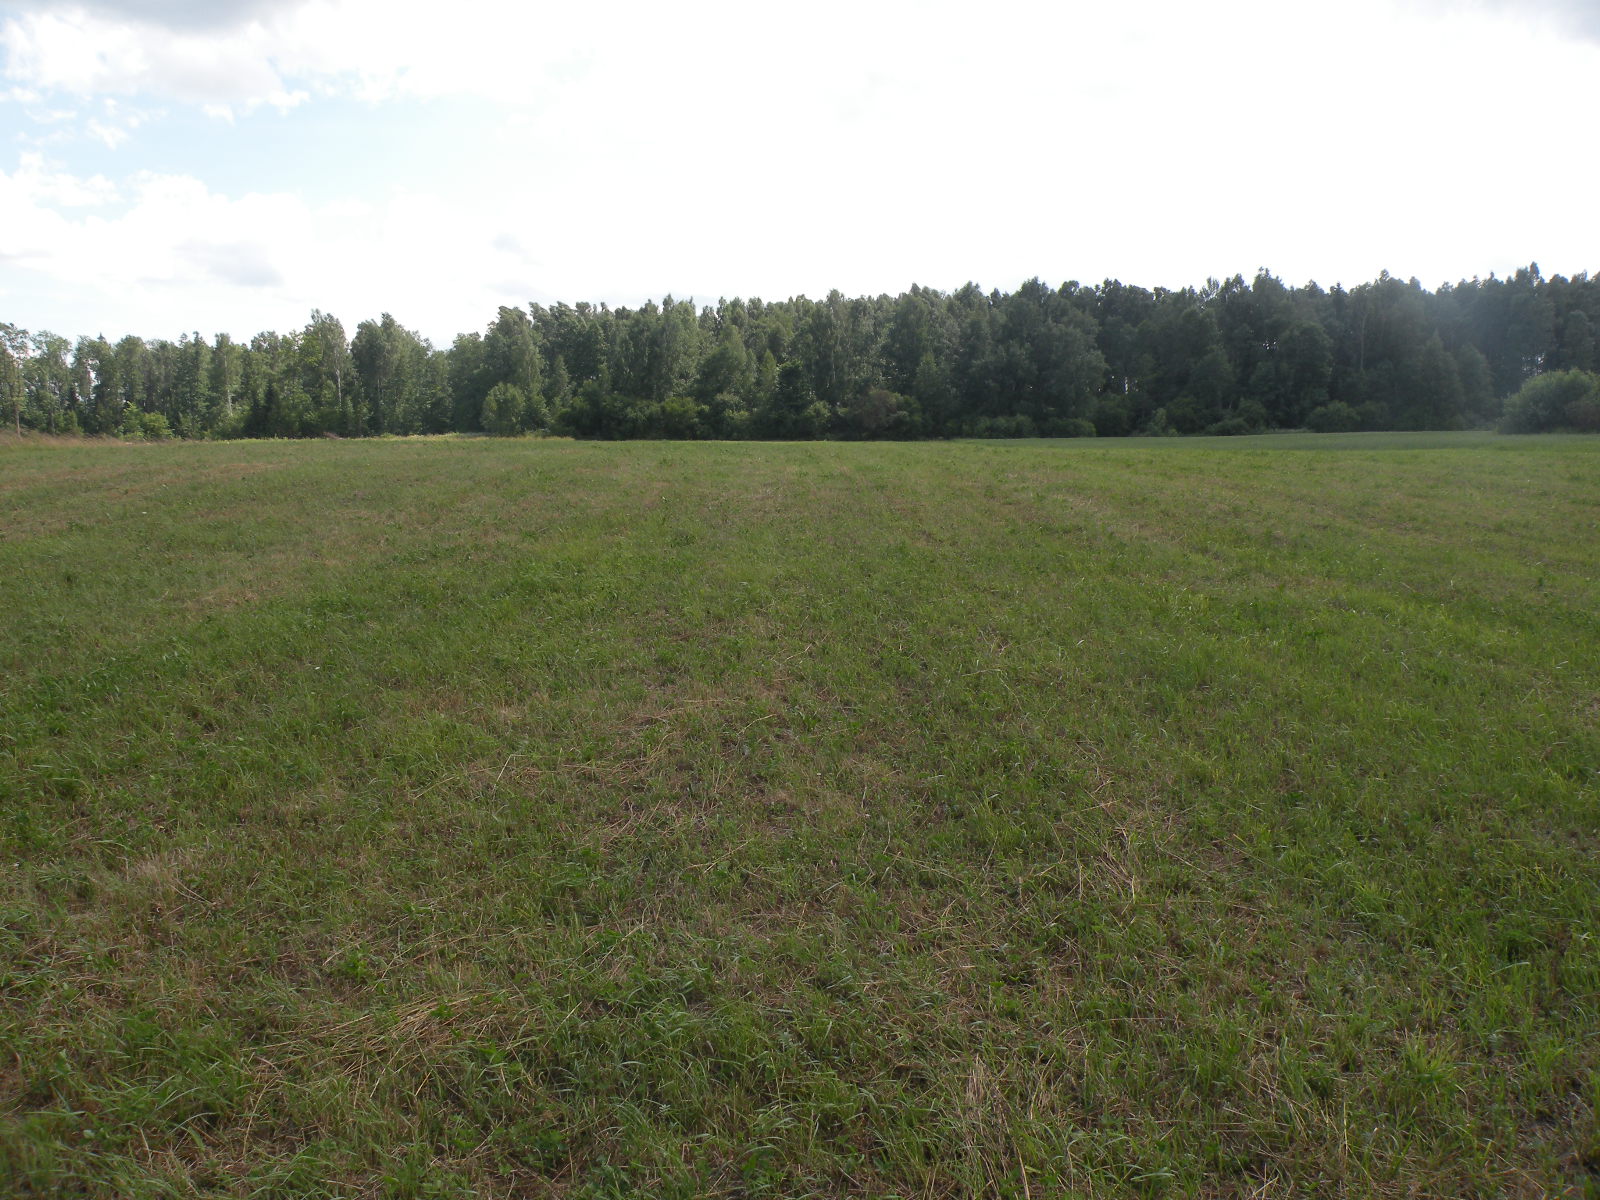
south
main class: Grassland
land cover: Grassland without tree/shrub cover
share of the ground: > 75 %
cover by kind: herbaceous plants 75 %, unconsolidated bare surface 25 %
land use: Agriculture (excluding fallow land and kitchen gardens)
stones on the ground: < 10 %
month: July
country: LV
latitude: 55.8335
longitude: 26.5824
